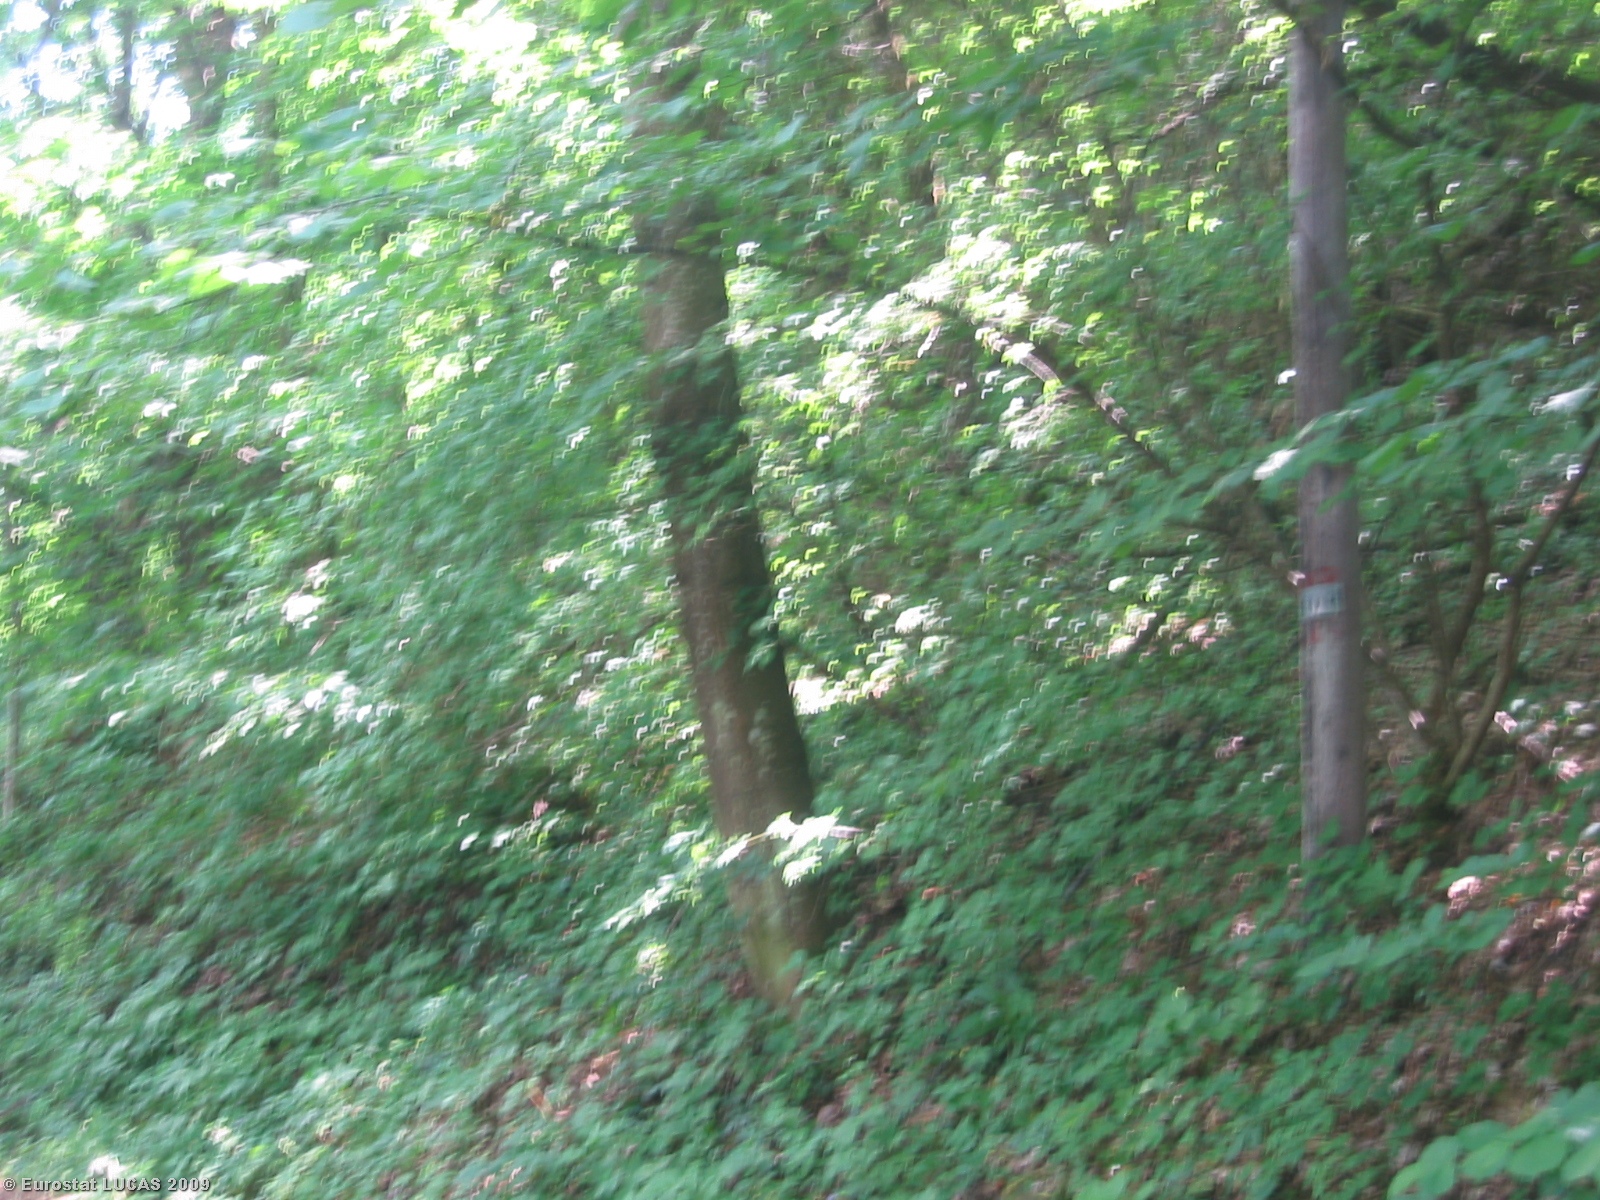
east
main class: Woodland
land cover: Mixed woodland
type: mesophytic deciduous forest
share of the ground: > 75 %
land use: Unused
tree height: > 5 m
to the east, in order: Mixed woodland; Artificial constructions in urban areas; Electric lines; Grassland without tree/shrub cover; Mixed woodland; Tracks; Mixed woodland
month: July
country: IT
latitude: 44.2572
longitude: 10.8122
